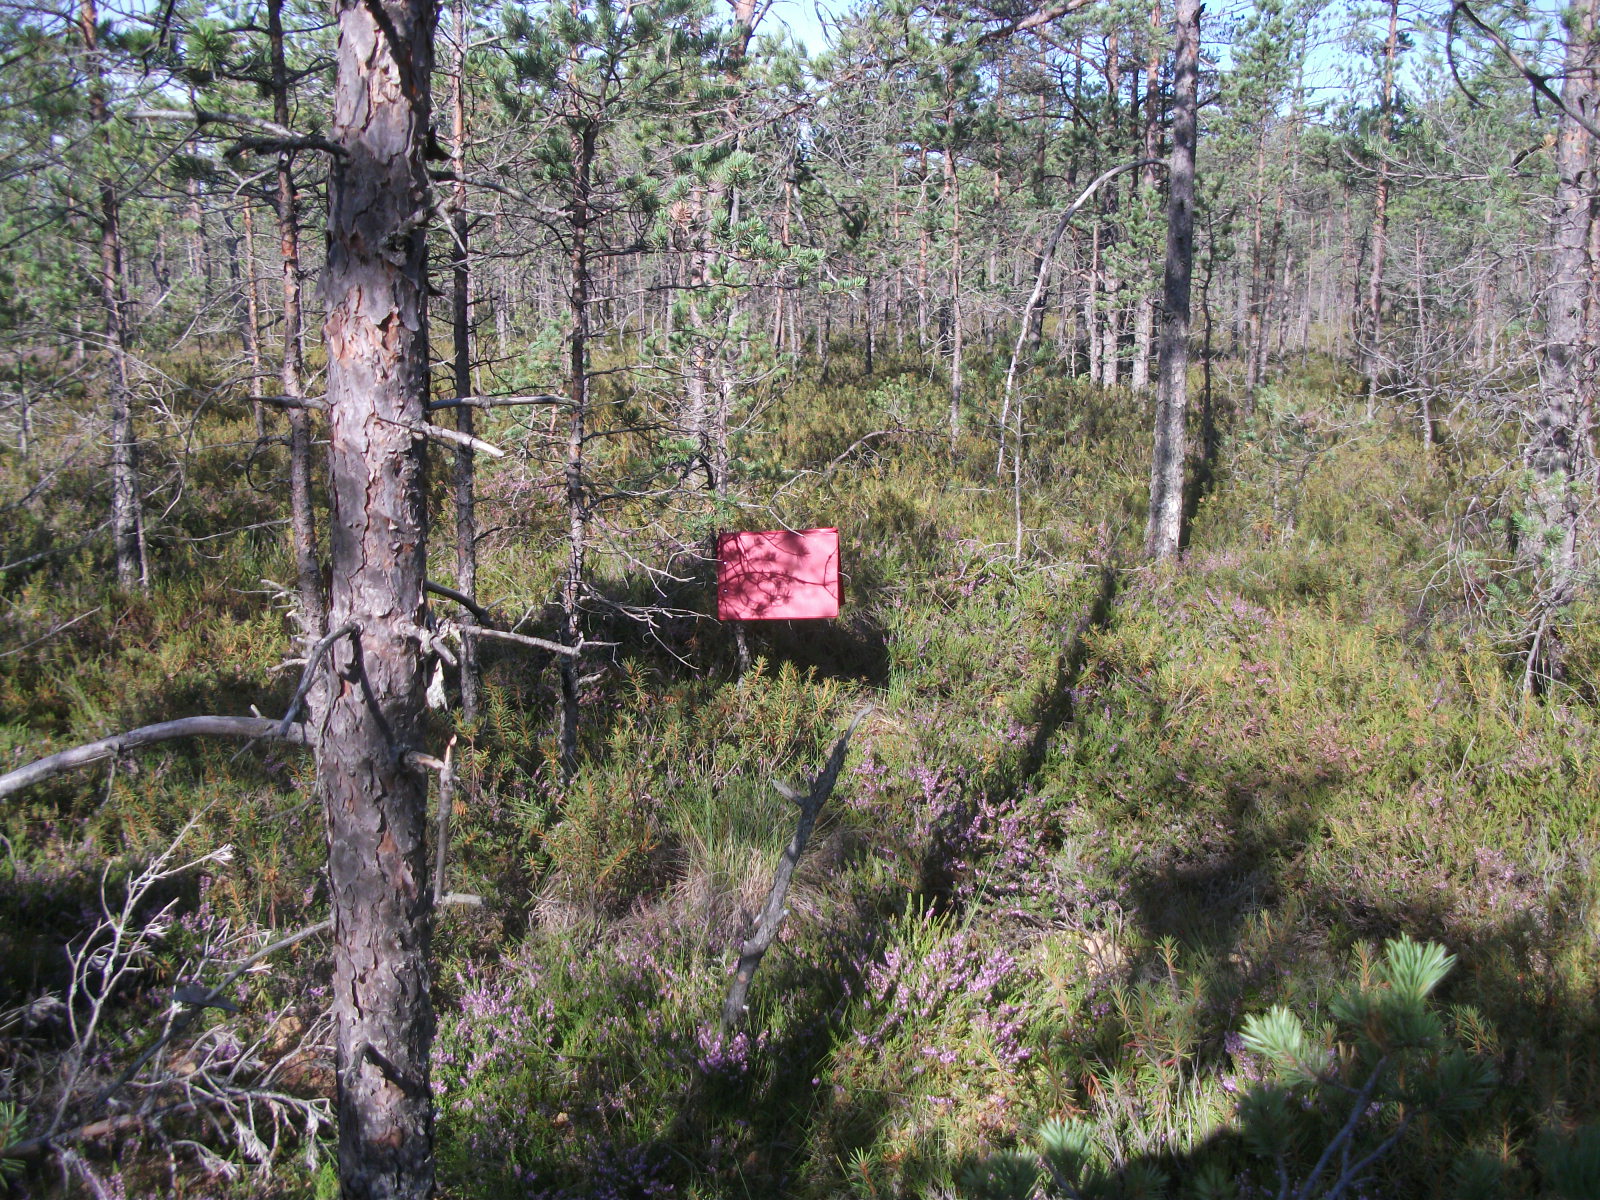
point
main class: Woodland
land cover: Pine dominated coniferous woodland
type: hemiboreal forest and nemoral coniferous forest and mixed broadleaved-coniferous forest
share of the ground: 50 - 75 %
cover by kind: coniferous forest trees 65 %, lichens and mosses 30 %, herbaceous plants 5 %
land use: Semi-natural and natural areas not in use
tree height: < 5 m
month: August
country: LV
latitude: 56.4204
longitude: 26.1717
